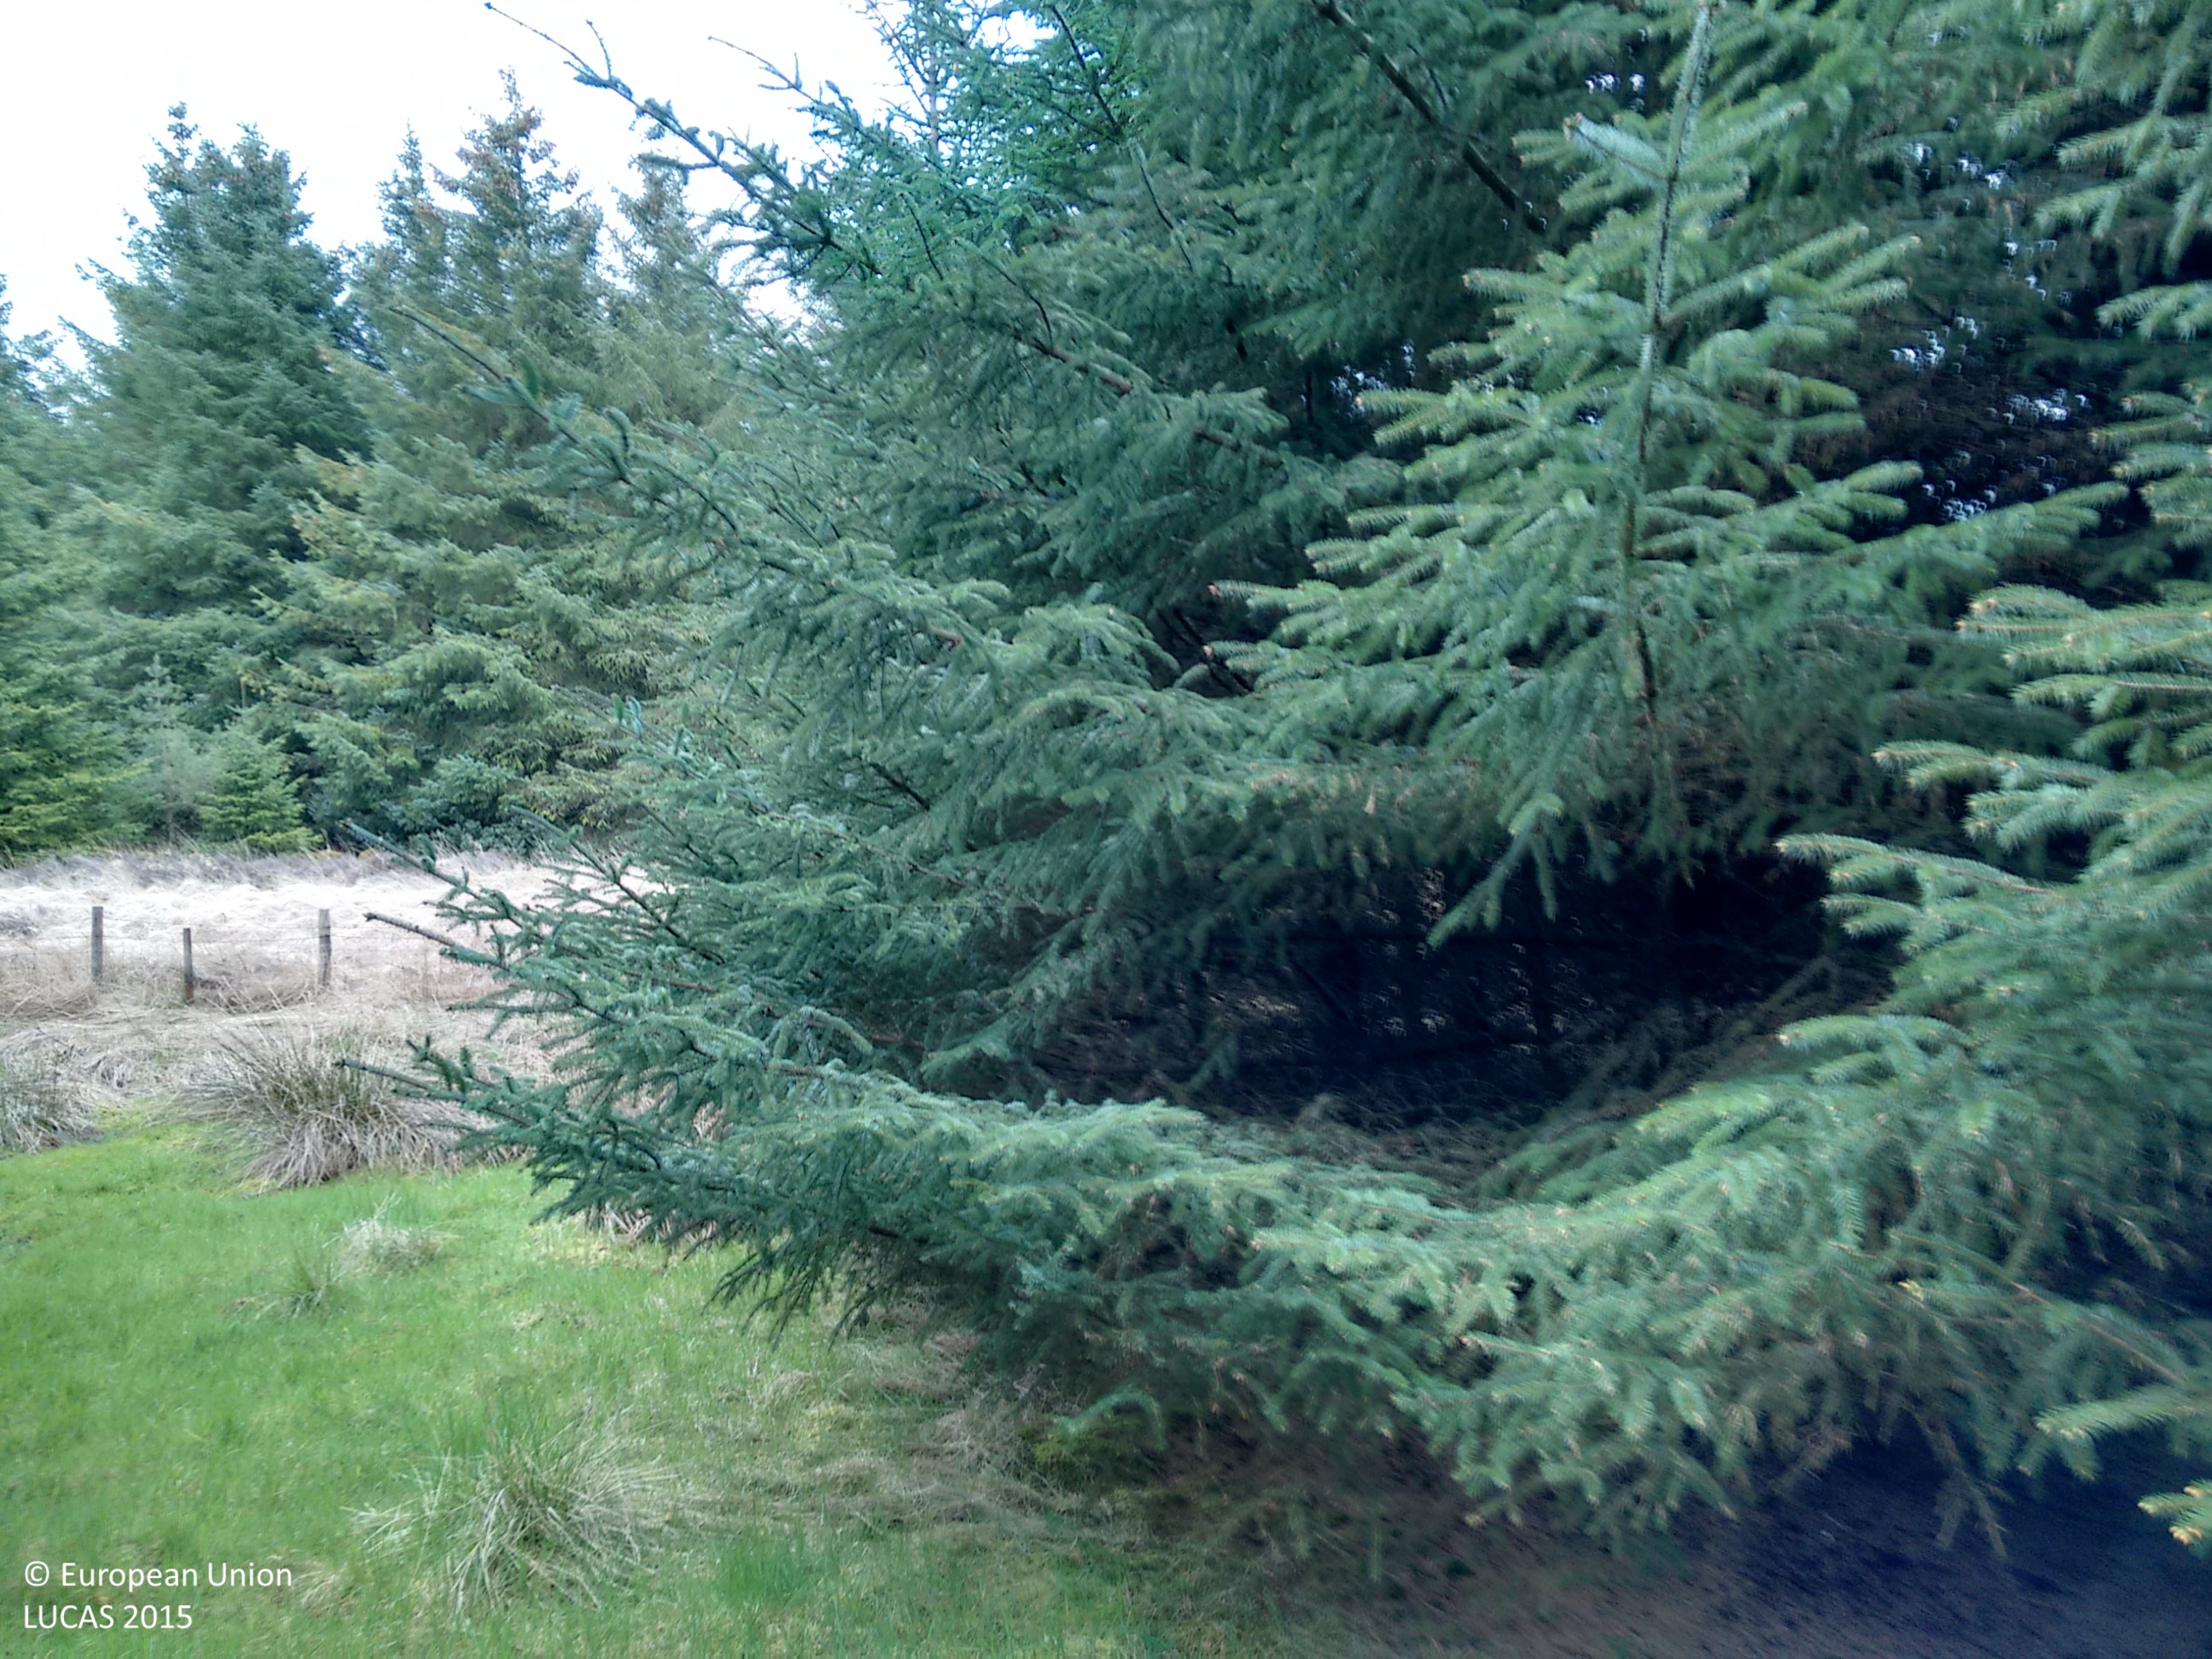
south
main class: Woodland
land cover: Spruce dominated coniferous woodland
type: hemiboreal forest and nemoral coniferous forest and mixed broadleaved-coniferous forest
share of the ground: > 75 %
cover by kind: coniferous forest trees 100 %
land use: Forestry
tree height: > 5 m
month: May
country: GB
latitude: 55.9554
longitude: -3.9075
